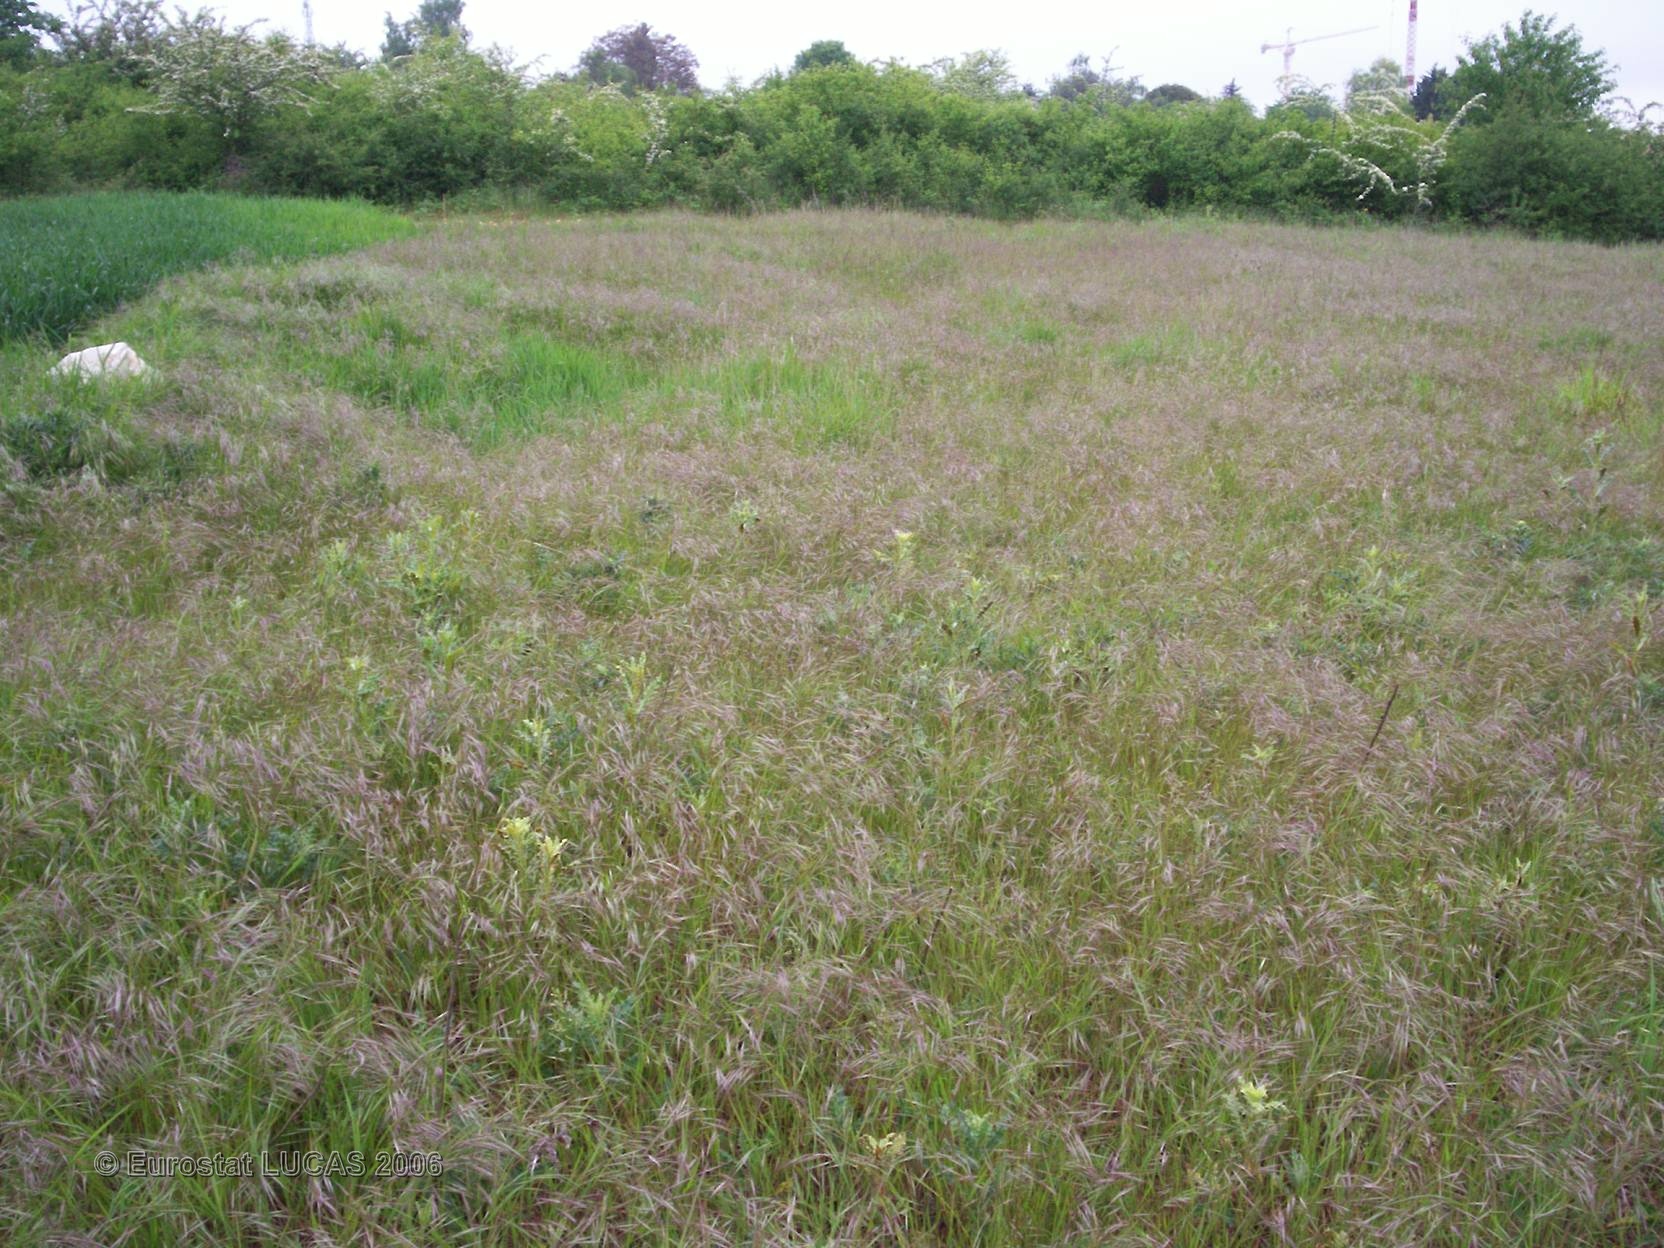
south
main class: Grassland
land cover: Grassland without tree/shrub cover
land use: Agriculture (excluding fallow land and kitchen gardens)
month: May
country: FR
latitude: 46.5883
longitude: 0.3885
